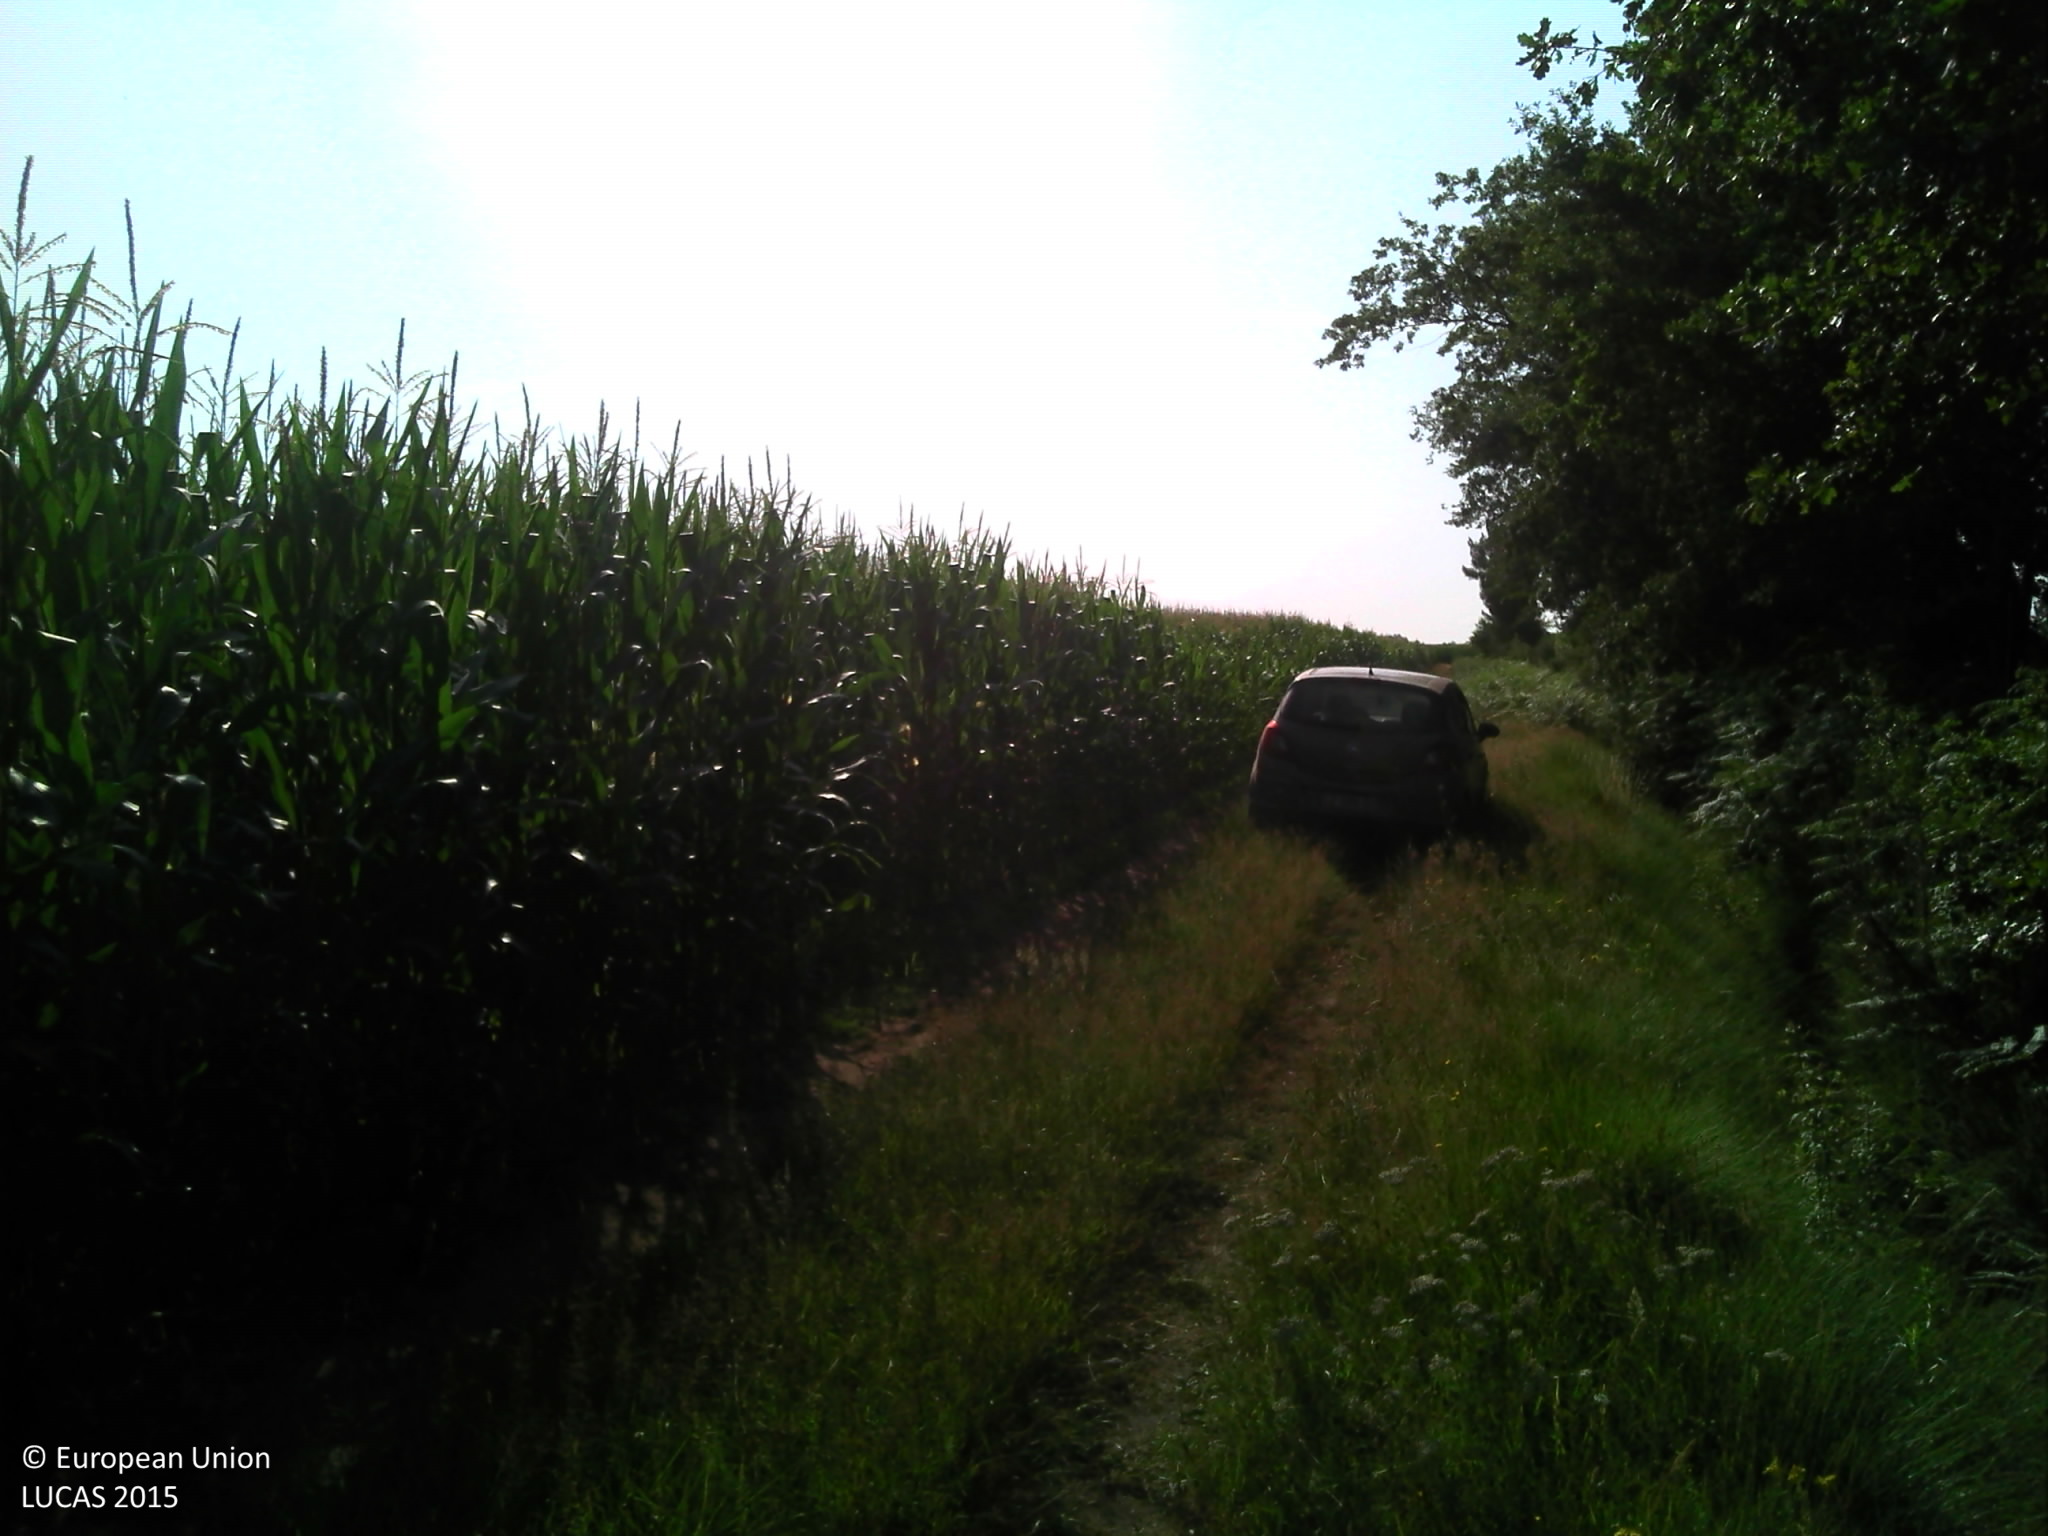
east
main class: Woodland
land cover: Broadleaved woodland
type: thermophilous deciduous forest
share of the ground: 50 - 75 %
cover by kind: broadleaved forest trees 75 %, herbaceous plants 15 %, coniferous forest trees 10 %
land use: Forestry
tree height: > 5 m
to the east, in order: Broadleaved woodland; Spontaneously vegetated surfaces; Ditches and canals; Abandoned hedges; Spontaneously vegetated surfaces; Abandoned hedges; Fences; Ditches and canals; Grass margins; Tracks; Maize
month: July
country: FR
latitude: 44.1281
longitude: -0.6504
